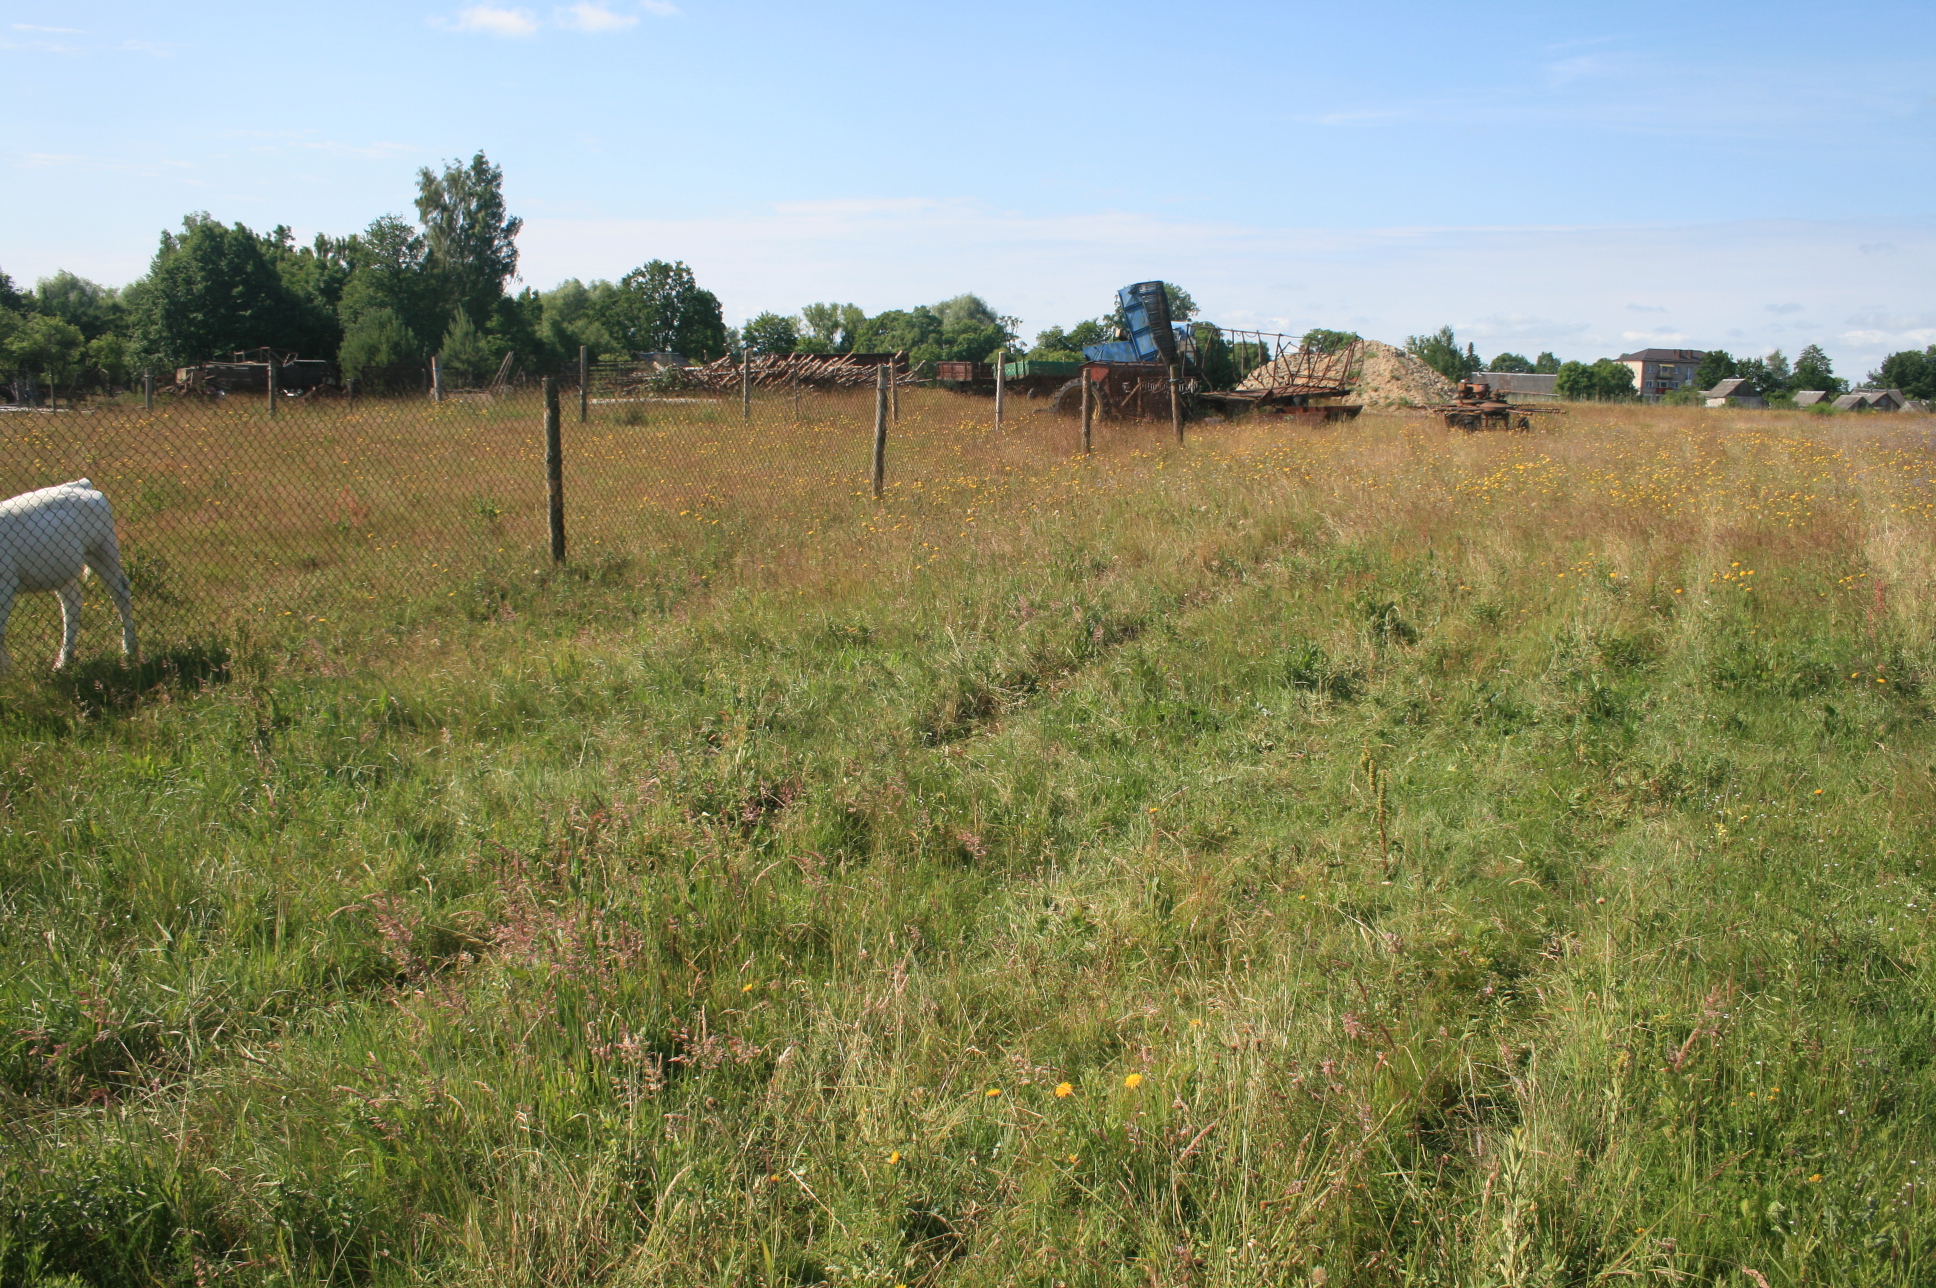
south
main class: Grassland
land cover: Grassland without tree/shrub cover
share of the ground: > 75 %
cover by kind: herbaceous plants 100 %
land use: Agriculture (excluding fallow land and kitchen gardens)
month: June
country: LT
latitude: 55.2320
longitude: 21.7009
